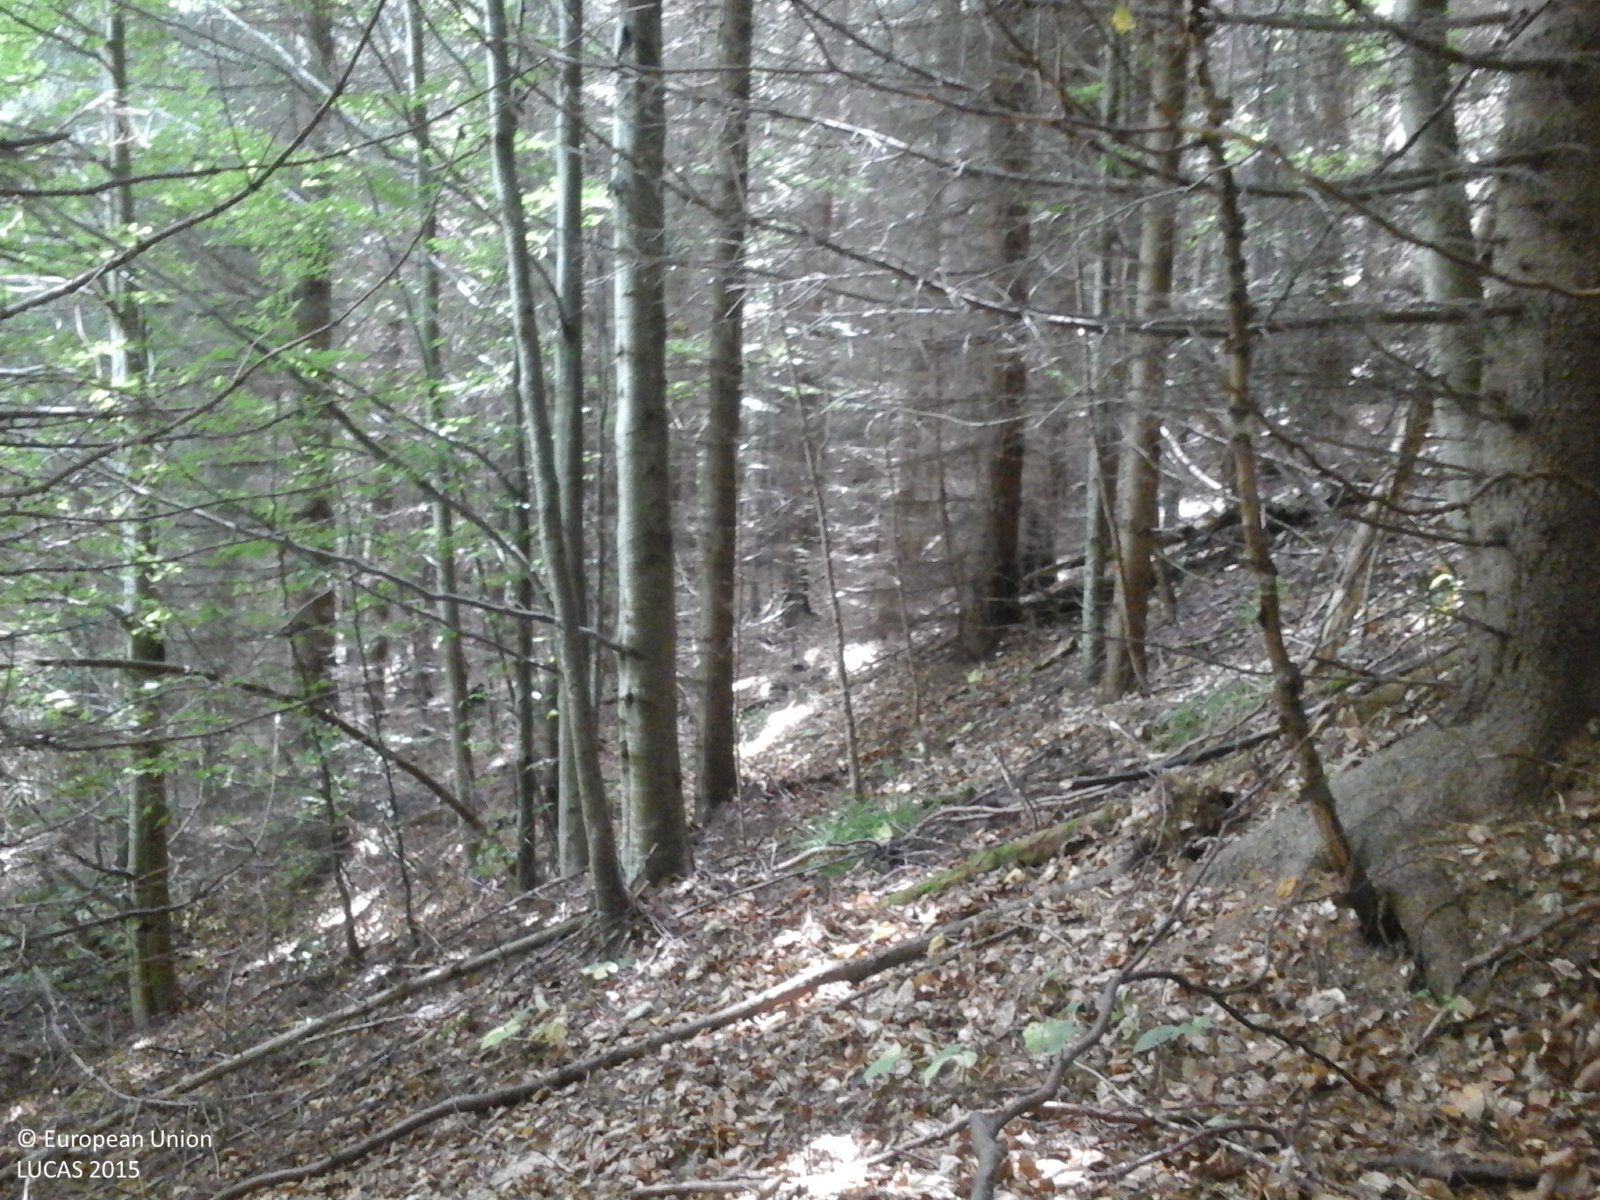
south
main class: Woodland
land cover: Spruce dominated mixed woodland
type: alpine coniferous forest
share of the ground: > 75 %
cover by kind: coniferous forest trees 60 %, broadleaved forest trees 40 %
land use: Forestry
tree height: > 5 m
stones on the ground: 10 - 25 %
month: July
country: RO
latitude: 45.4286
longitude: 24.5094
